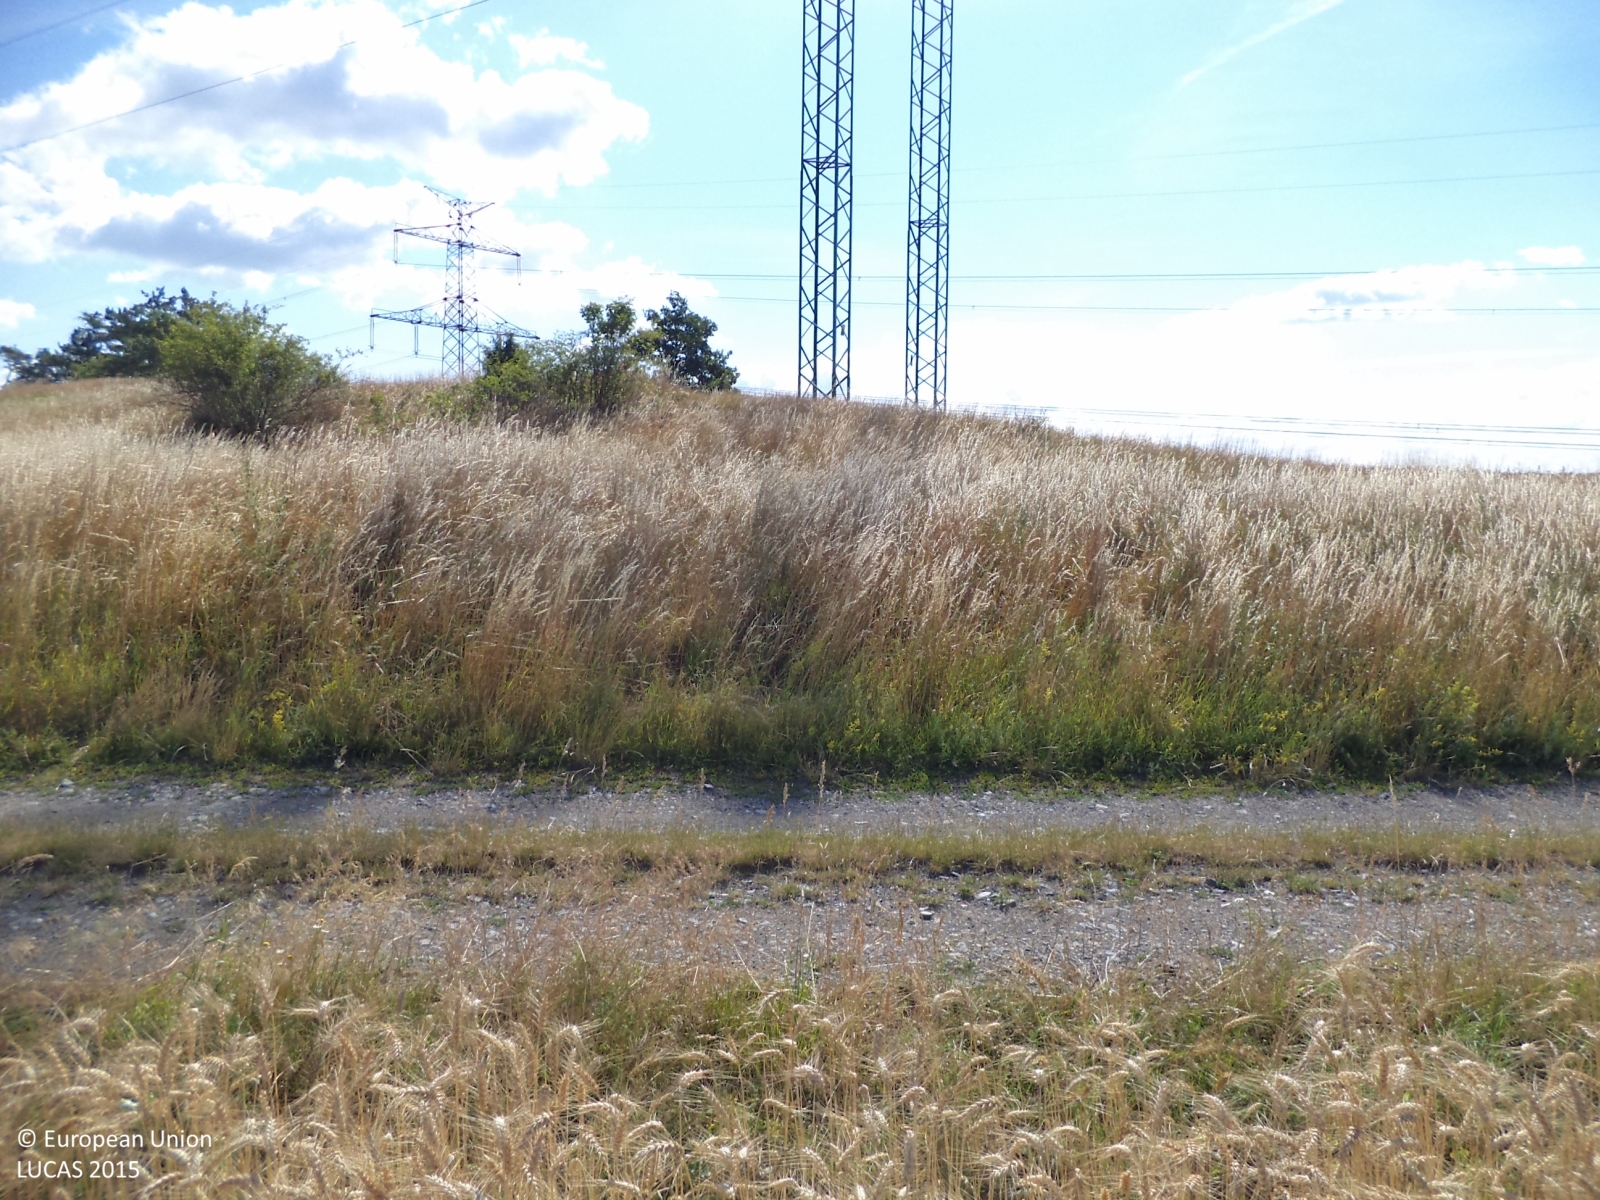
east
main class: Cropland
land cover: Common wheat
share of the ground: > 75 %
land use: Agriculture (excluding fallow land and kitchen gardens)
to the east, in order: Common wheat; Grass margins; Tracks; Grassland without tree/shrub cover; Grassland with sparse tree/shrub cover; Grassland without tree/shrub cover; Electric lines; Tracks; Grassland with sparse tree/shrub cover; Common wheat; Electric lines; Common wheat
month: July
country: CZ
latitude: 49.8321
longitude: 14.3250
